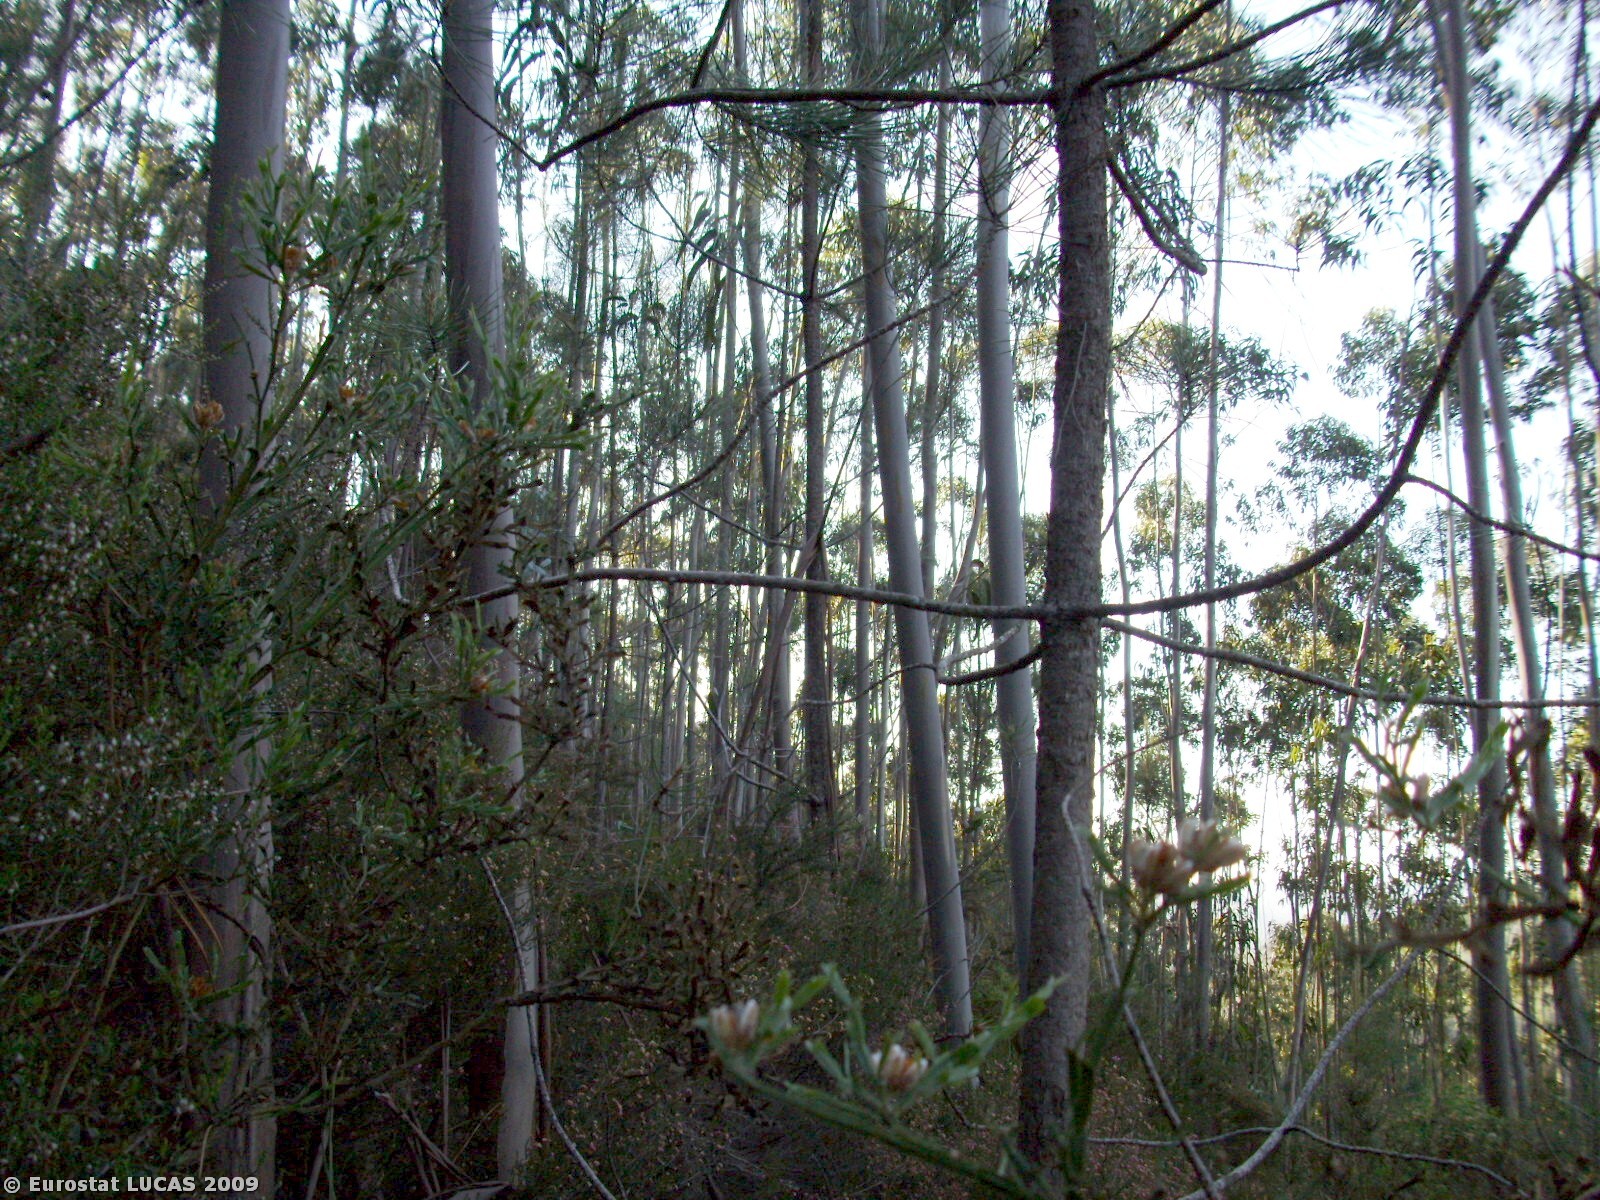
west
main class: Woodland
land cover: Broadleaved woodland
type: plantations and self-sown exotic forest
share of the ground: > 75 %
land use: Forestry
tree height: > 5 m
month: May
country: PT
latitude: 40.7408
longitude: -8.4366
